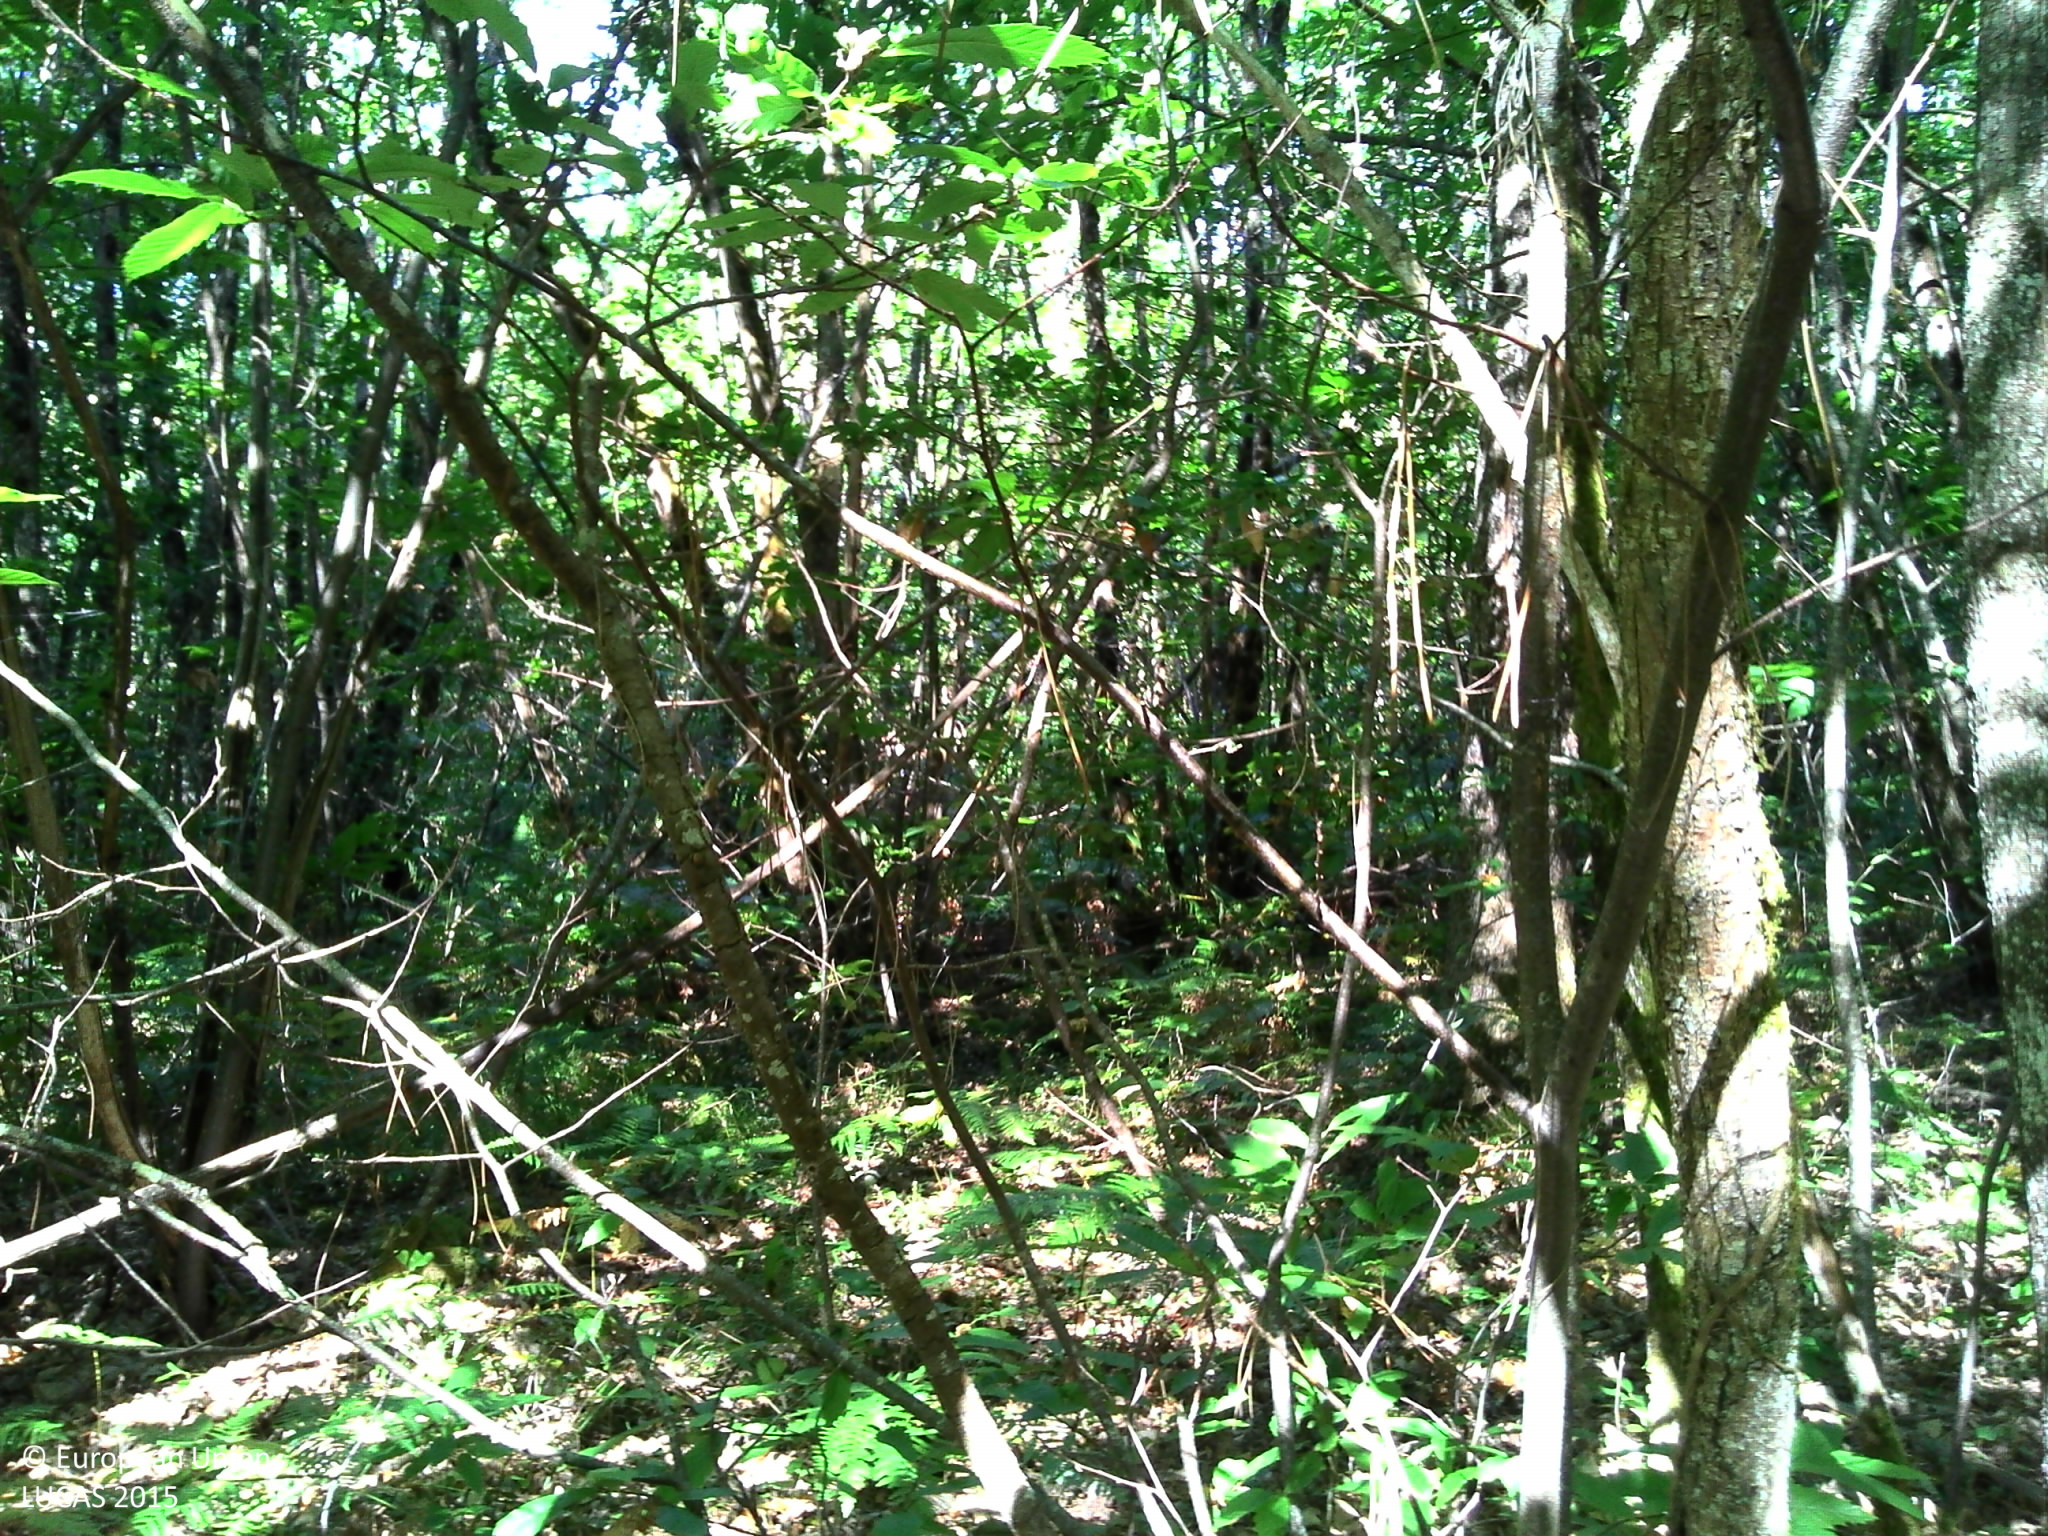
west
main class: Woodland
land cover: Broadleaved woodland
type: thermophilous deciduous forest
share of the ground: > 75 %
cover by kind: broadleaved forest trees 90 %, herbaceous plants 5 %, lichens and mosses 5 %
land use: Forestry
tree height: > 5 m
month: July
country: FR
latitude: 44.9368
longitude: 0.5751
